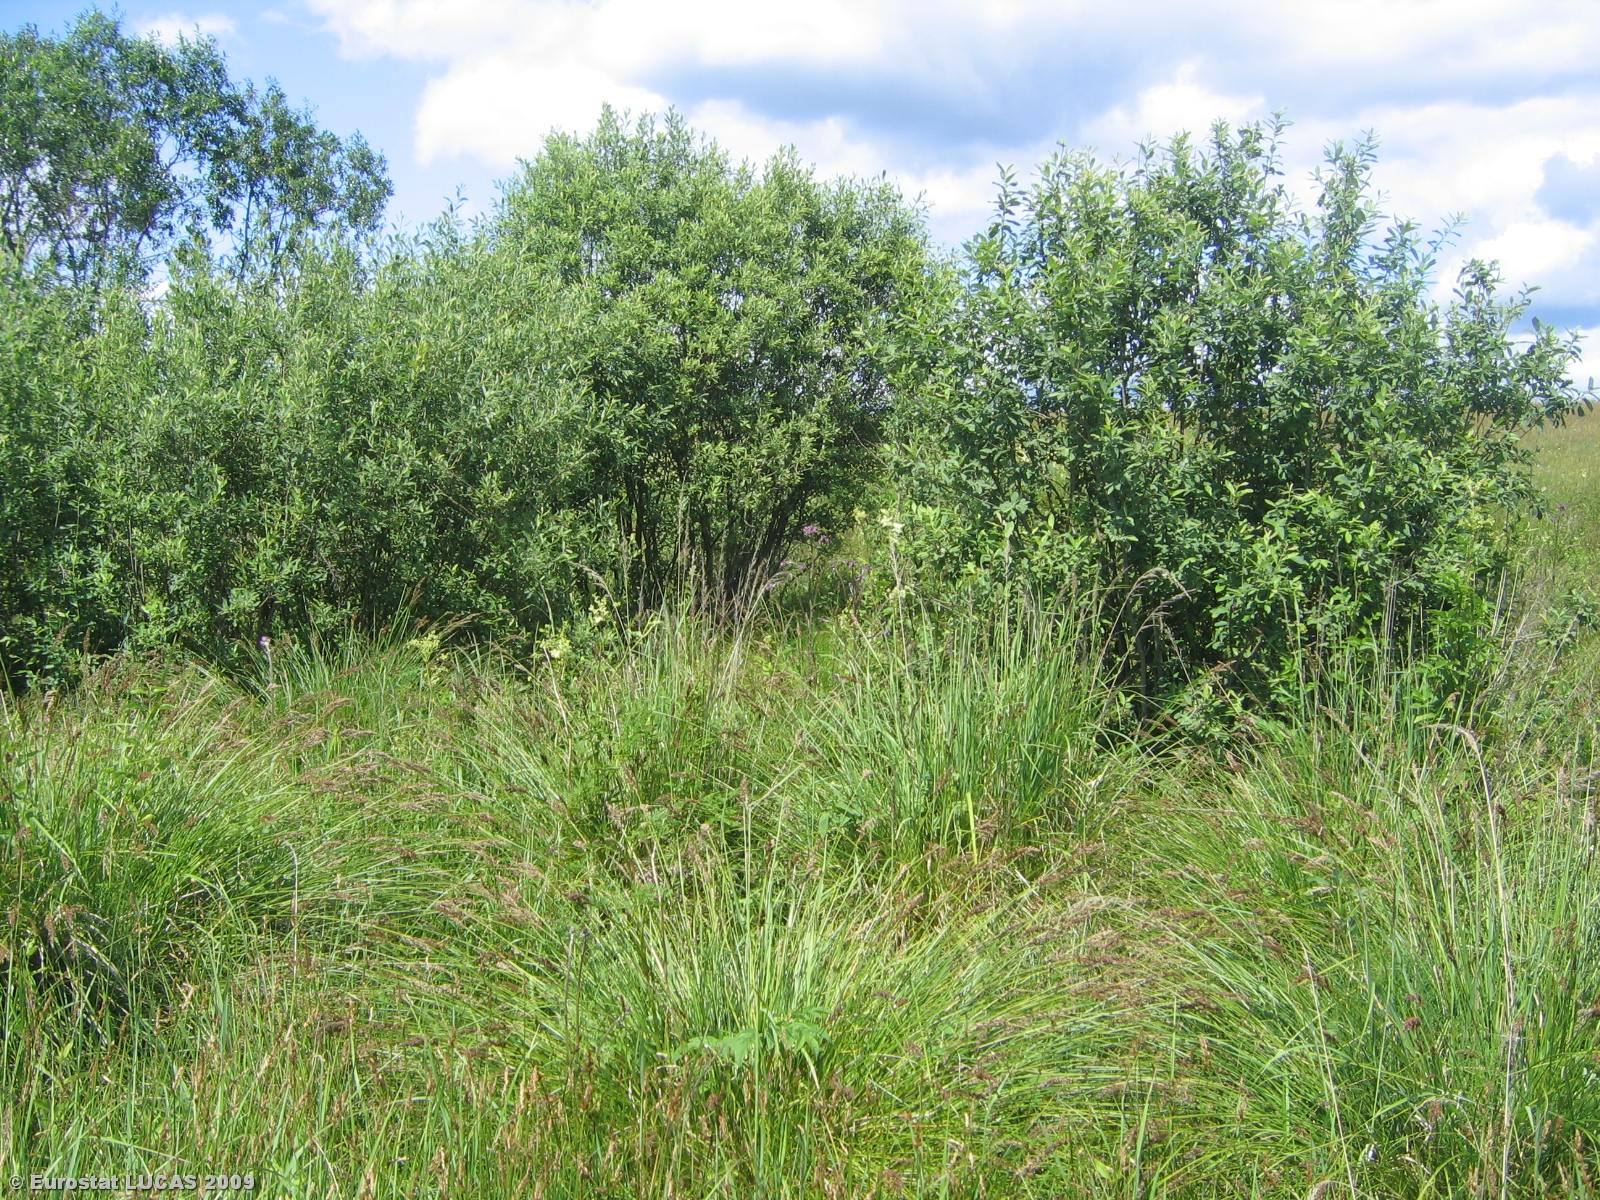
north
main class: Grassland
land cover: Grassland with sparse tree/shrub cover
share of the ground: > 75 %
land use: Agriculture (excluding fallow land and kitchen gardens)
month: July
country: LT
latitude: 55.4351
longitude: 22.7889
